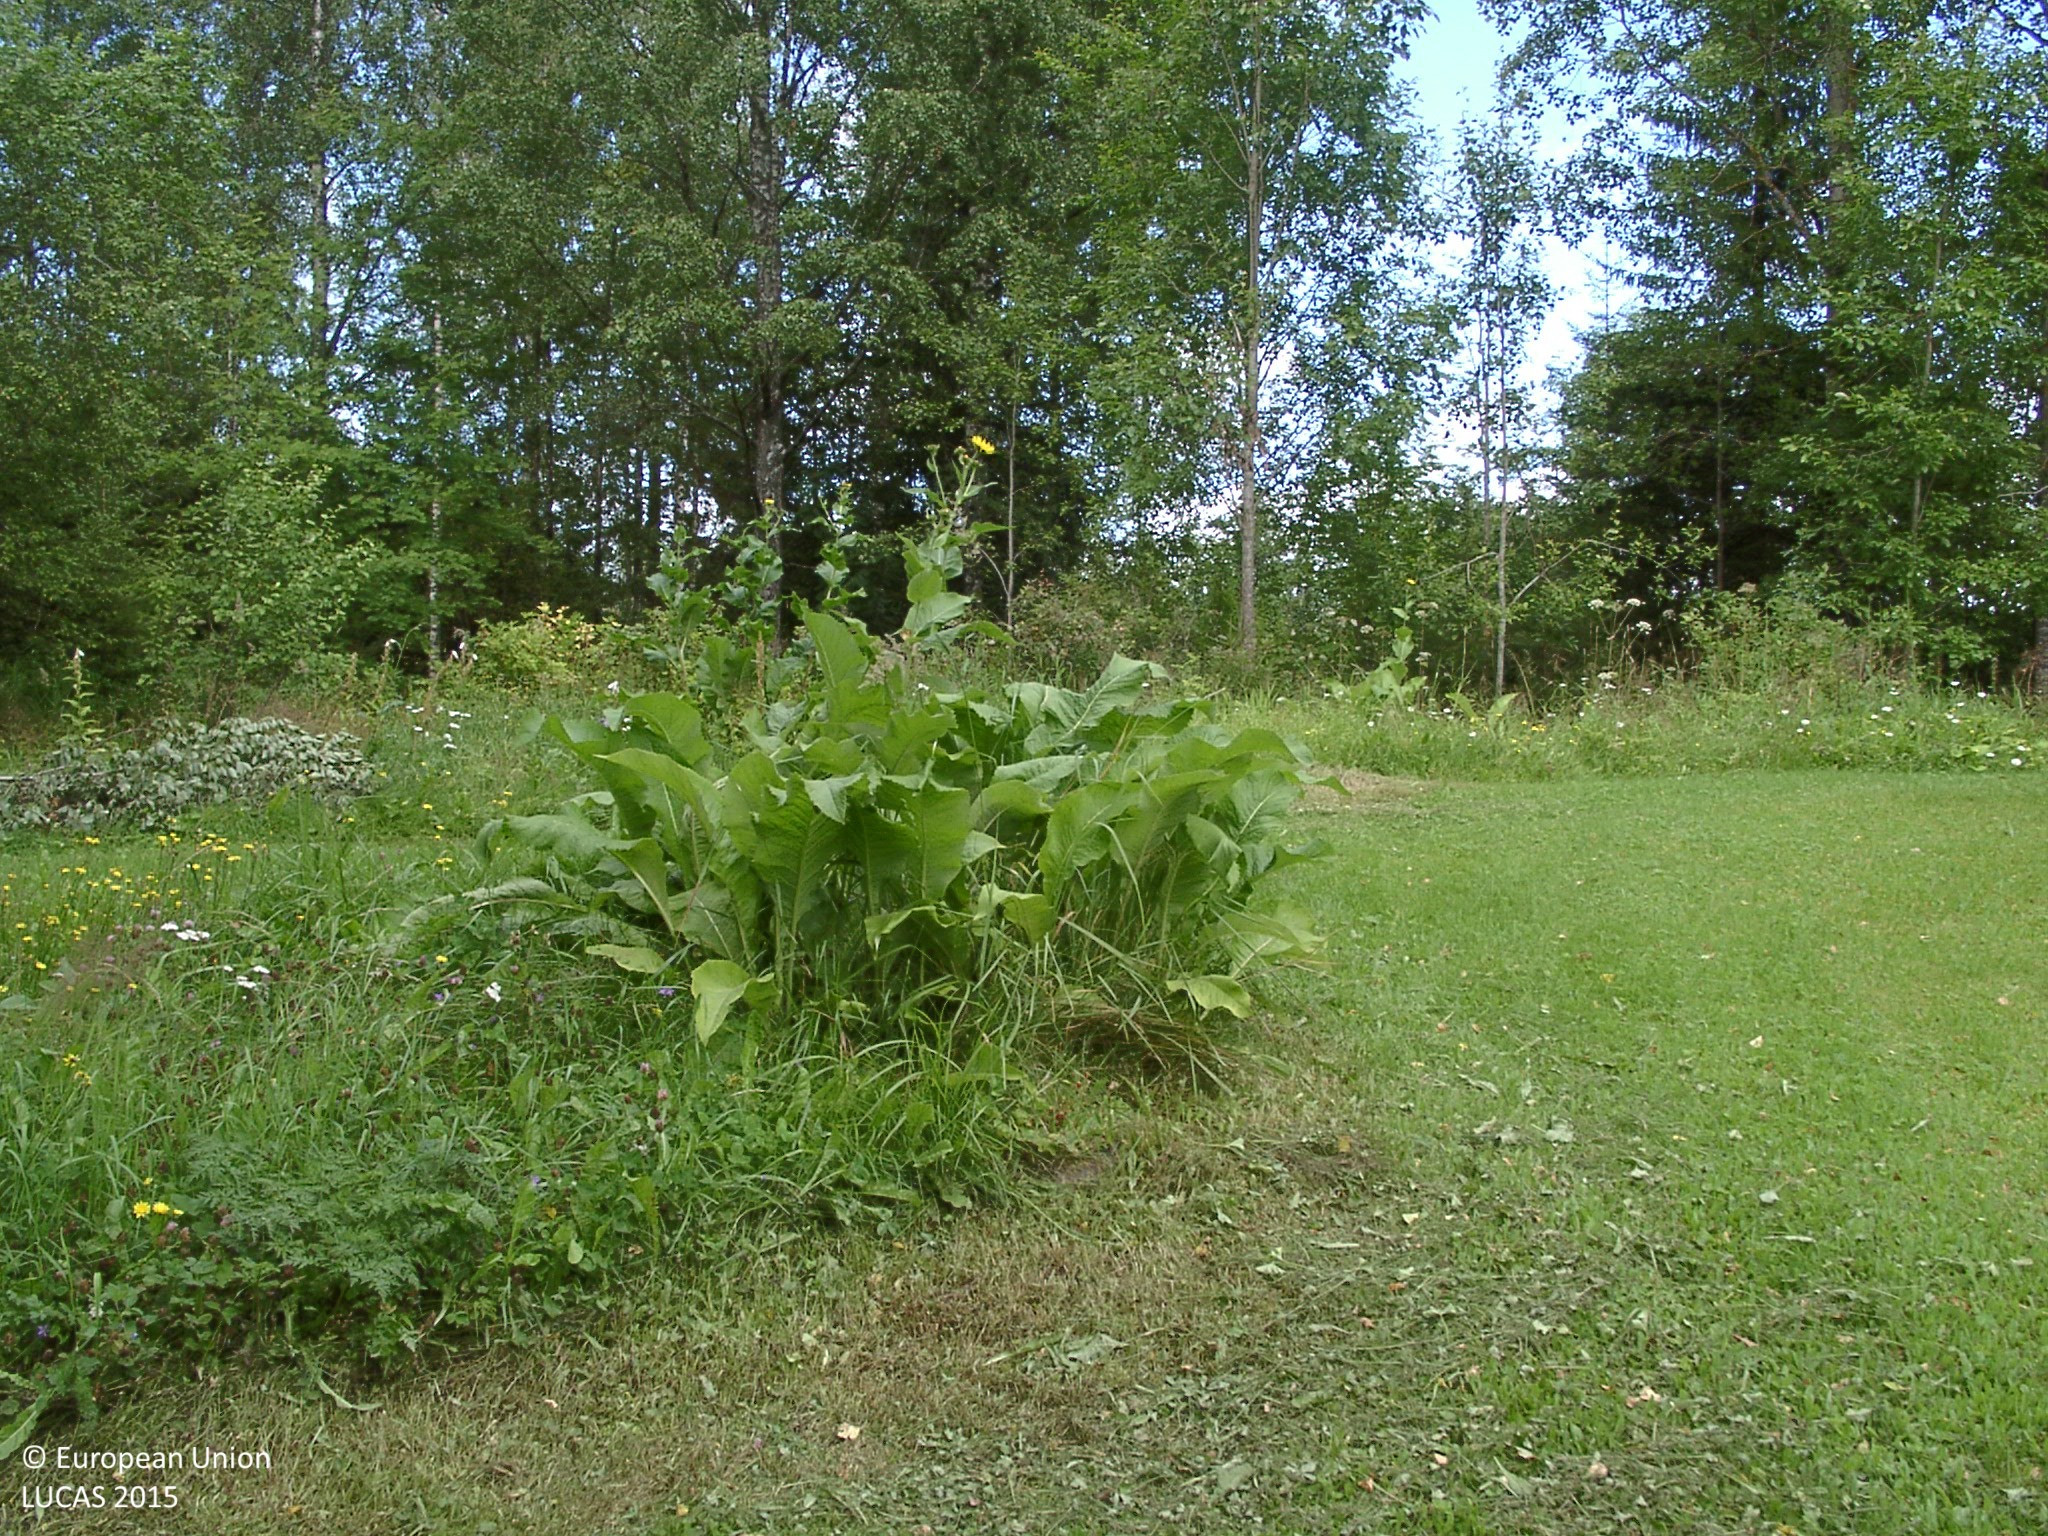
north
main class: Grassland
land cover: Grassland without tree/shrub cover
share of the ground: > 75 %
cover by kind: herbaceous plants 75 %, lichens and mosses 25 %
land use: Residential
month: August
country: FI
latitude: 62.4286
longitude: 25.5089
